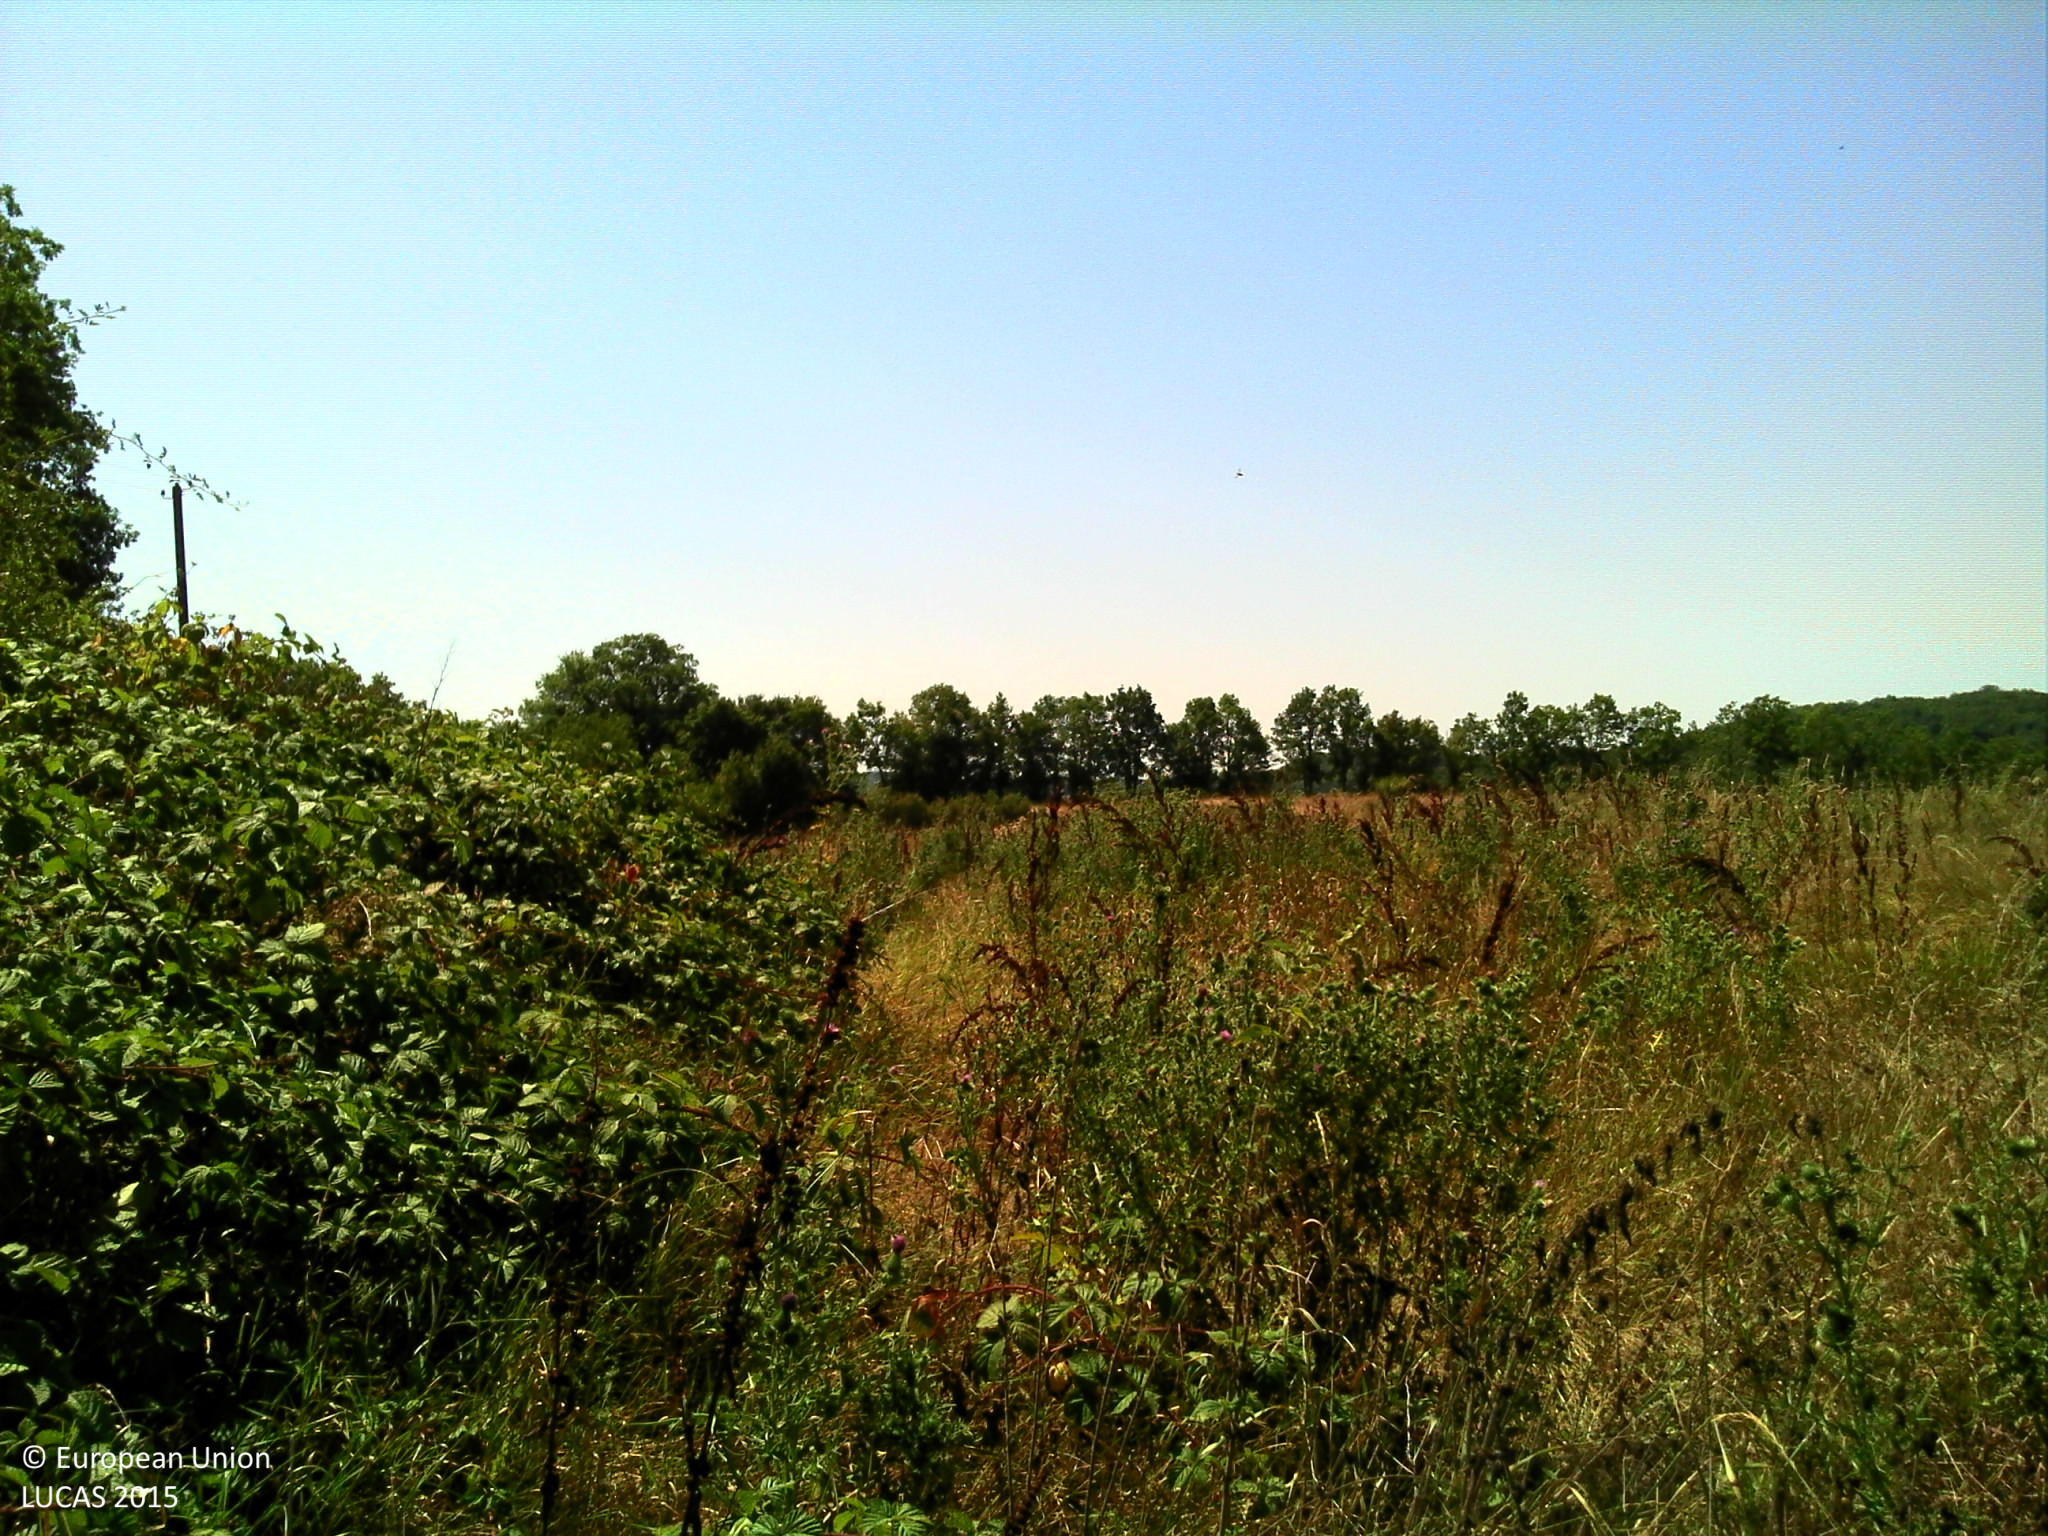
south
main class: Grassland
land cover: Spontaneously vegetated surfaces
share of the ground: > 75 %
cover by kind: herbaceous plants 100 %
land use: Fallow land
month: August
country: FR
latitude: 44.7403
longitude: 0.8117
